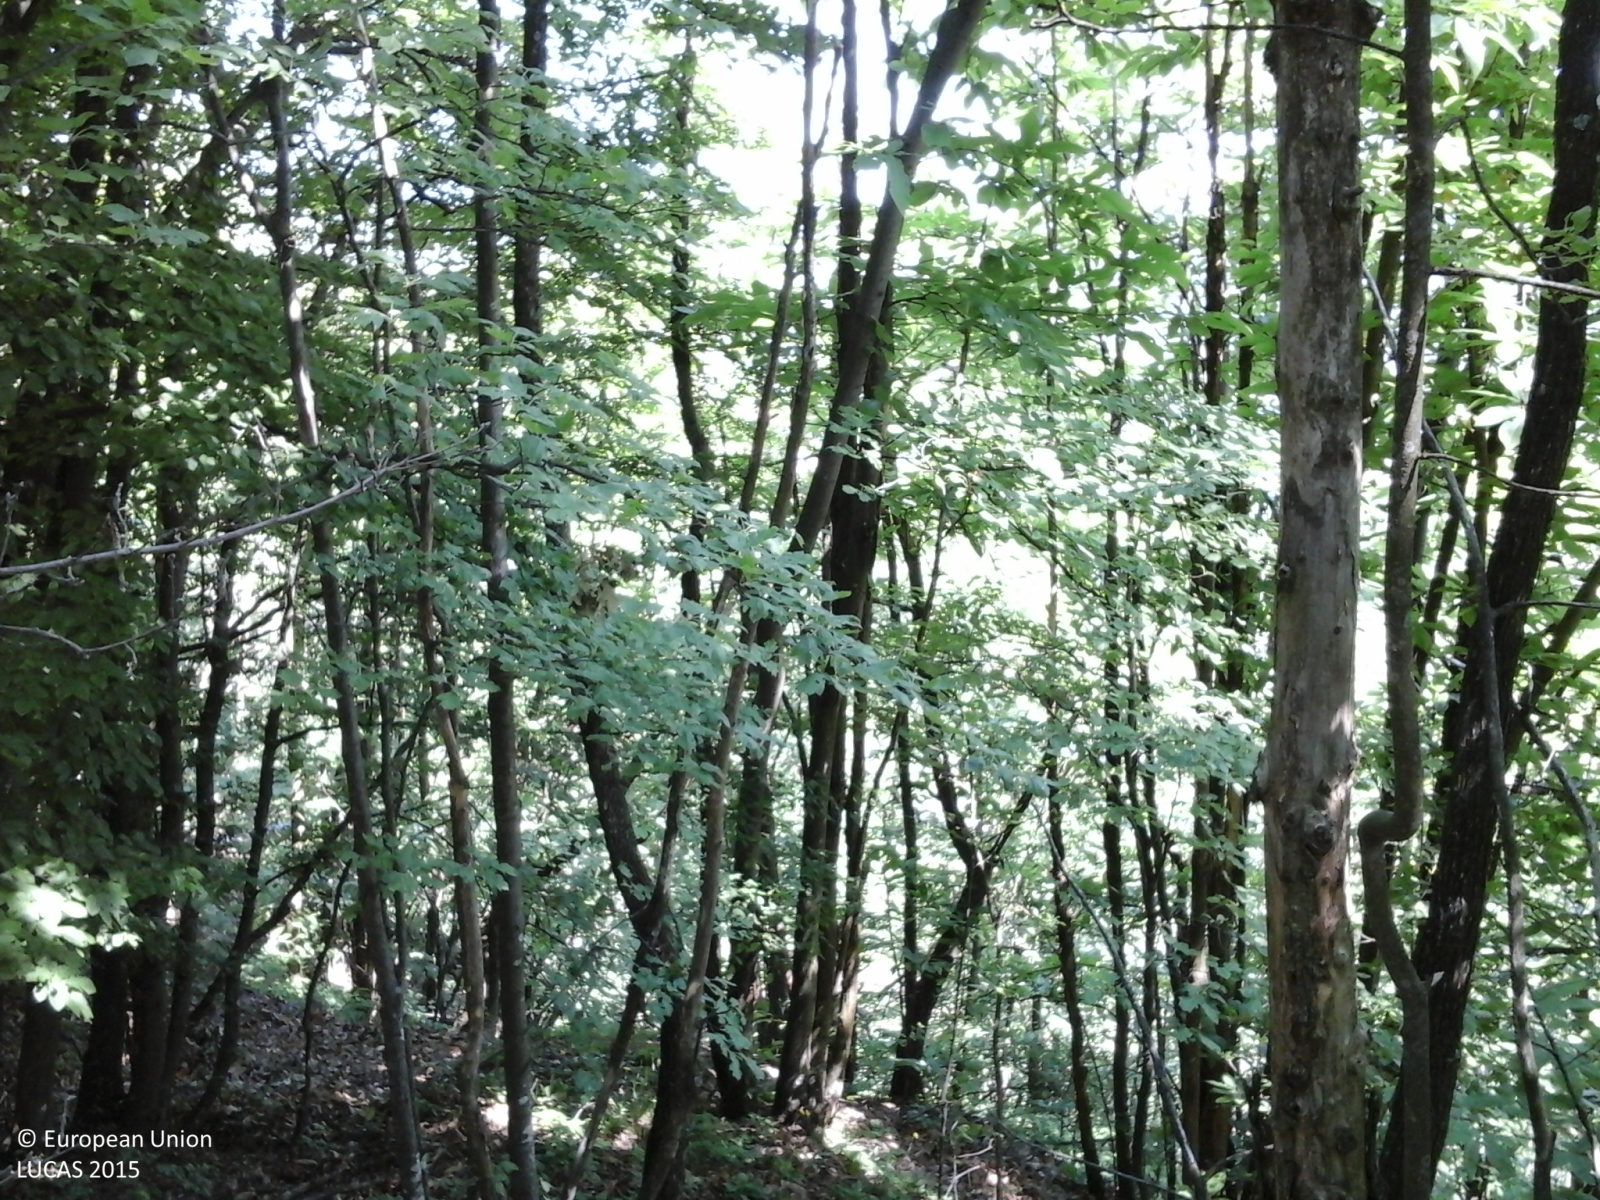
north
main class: Woodland
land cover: Broadleaved woodland
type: thermophilous deciduous forest
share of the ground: > 75 %
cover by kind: broadleaved forest trees 90 %, consolidated bare surface 10 %
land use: Forestry
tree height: > 5 m
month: May
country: IT
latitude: 44.4206
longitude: 10.6642
